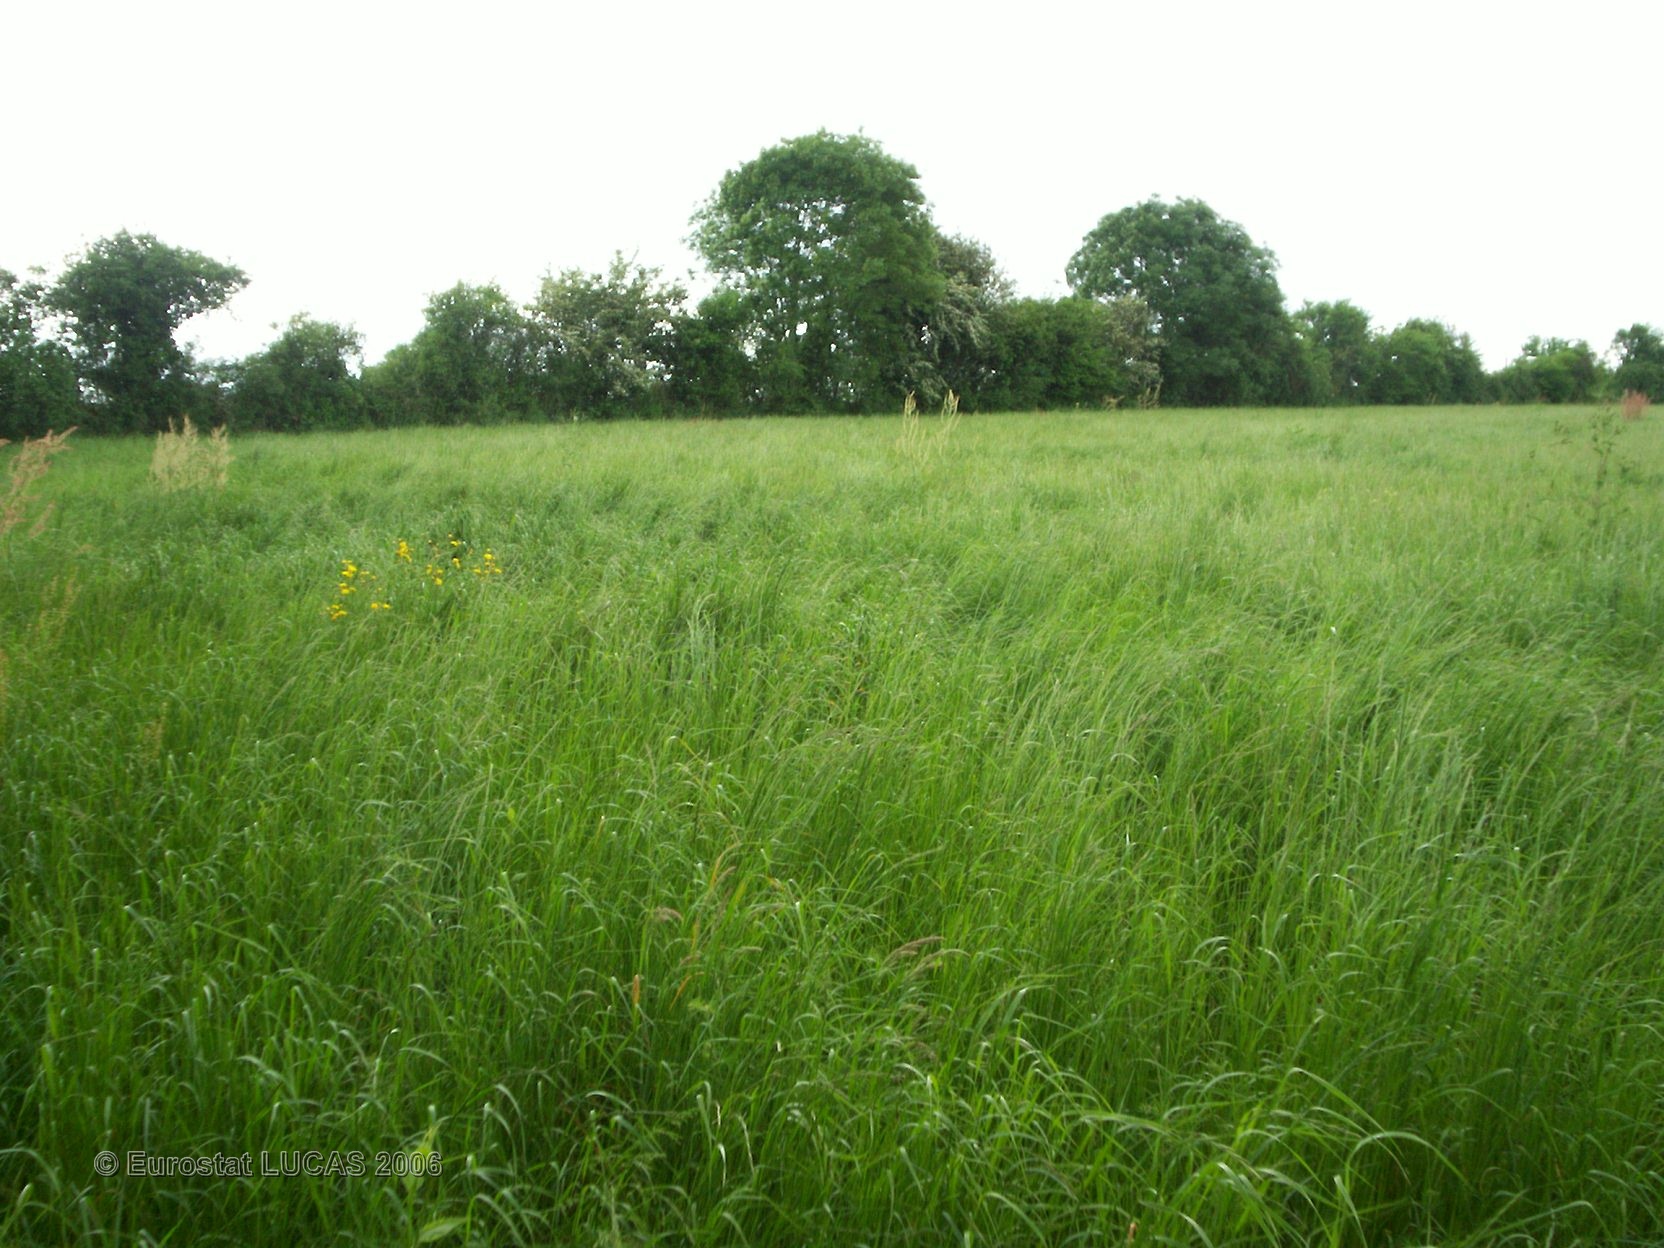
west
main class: Cropland
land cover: Other leguminous and mixtures for fodder
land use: Agriculture (excluding fallow land and kitchen gardens)
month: May
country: FR
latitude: 47.2111
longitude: -1.0606
